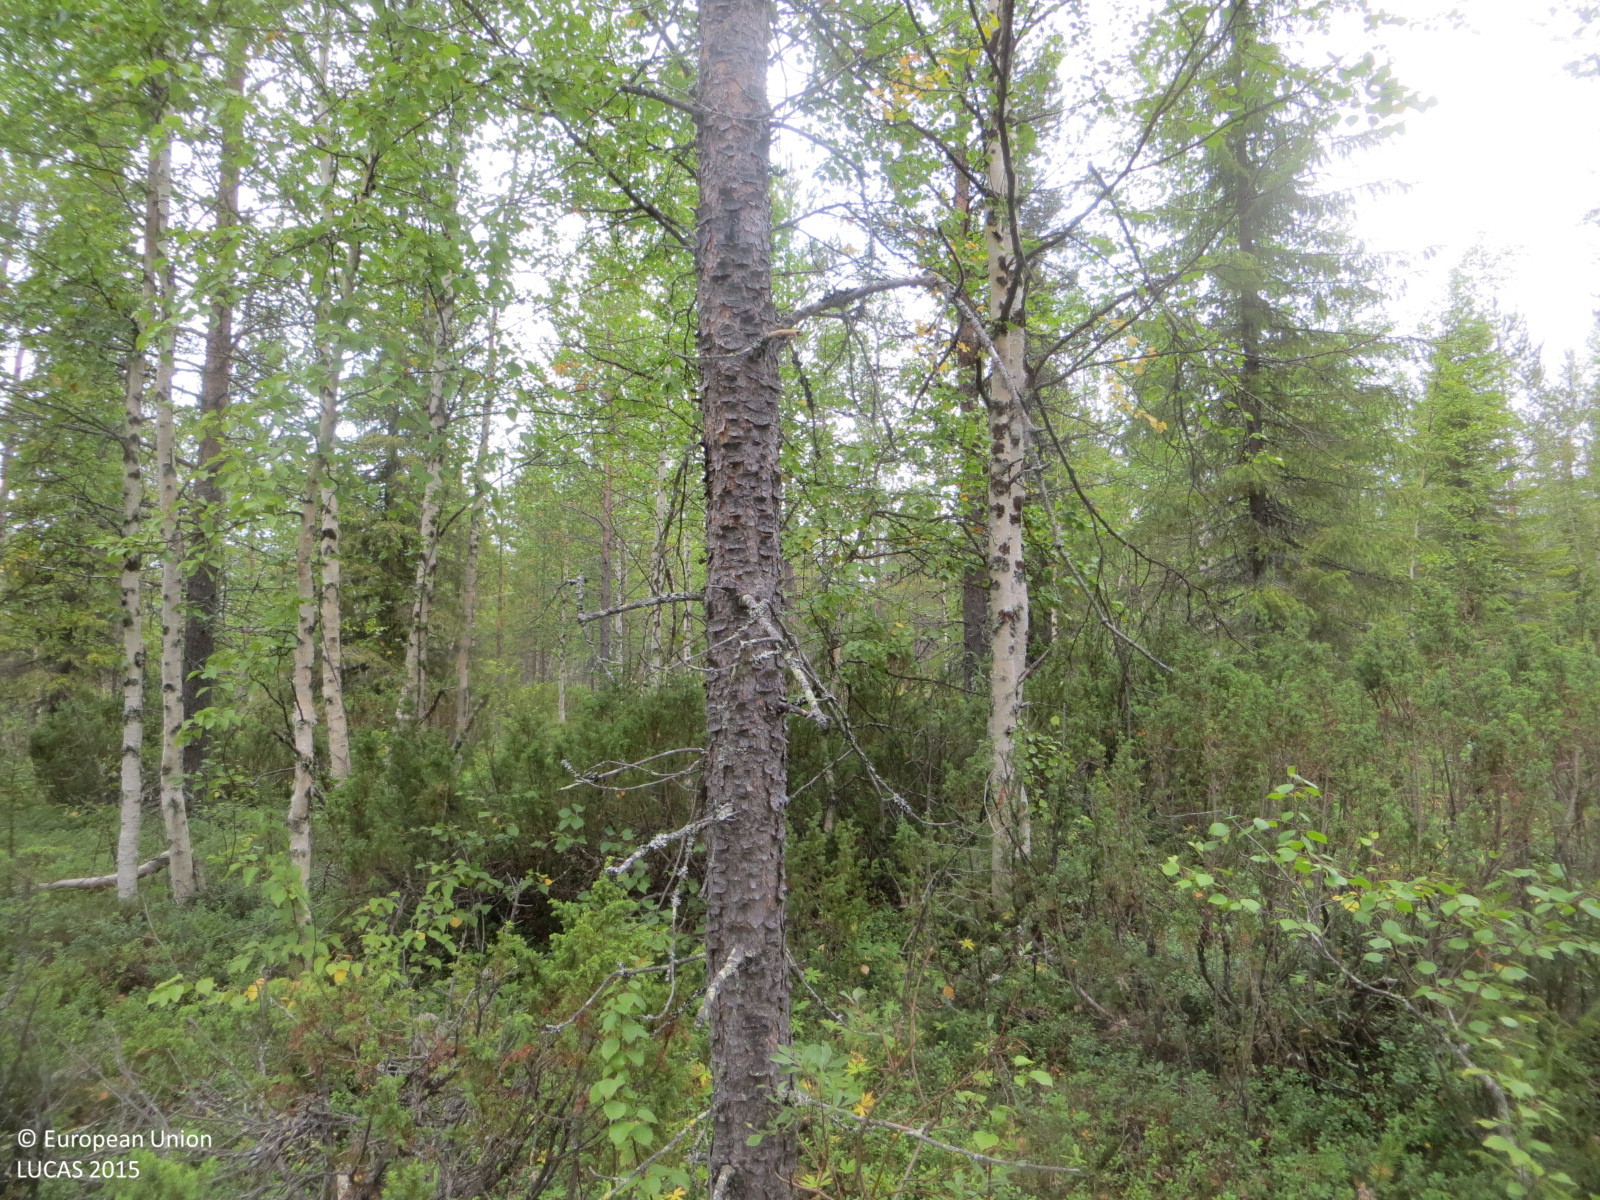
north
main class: Woodland
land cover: Pine dominated mixed woodland
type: boreal forest
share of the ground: 50 - 75 %
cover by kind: broadleaved forest trees 40 %, shrubs 40 %, coniferous forest trees 20 %
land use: Forestry
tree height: > 5 m
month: August
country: FI
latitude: 67.9943
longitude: 25.1732
